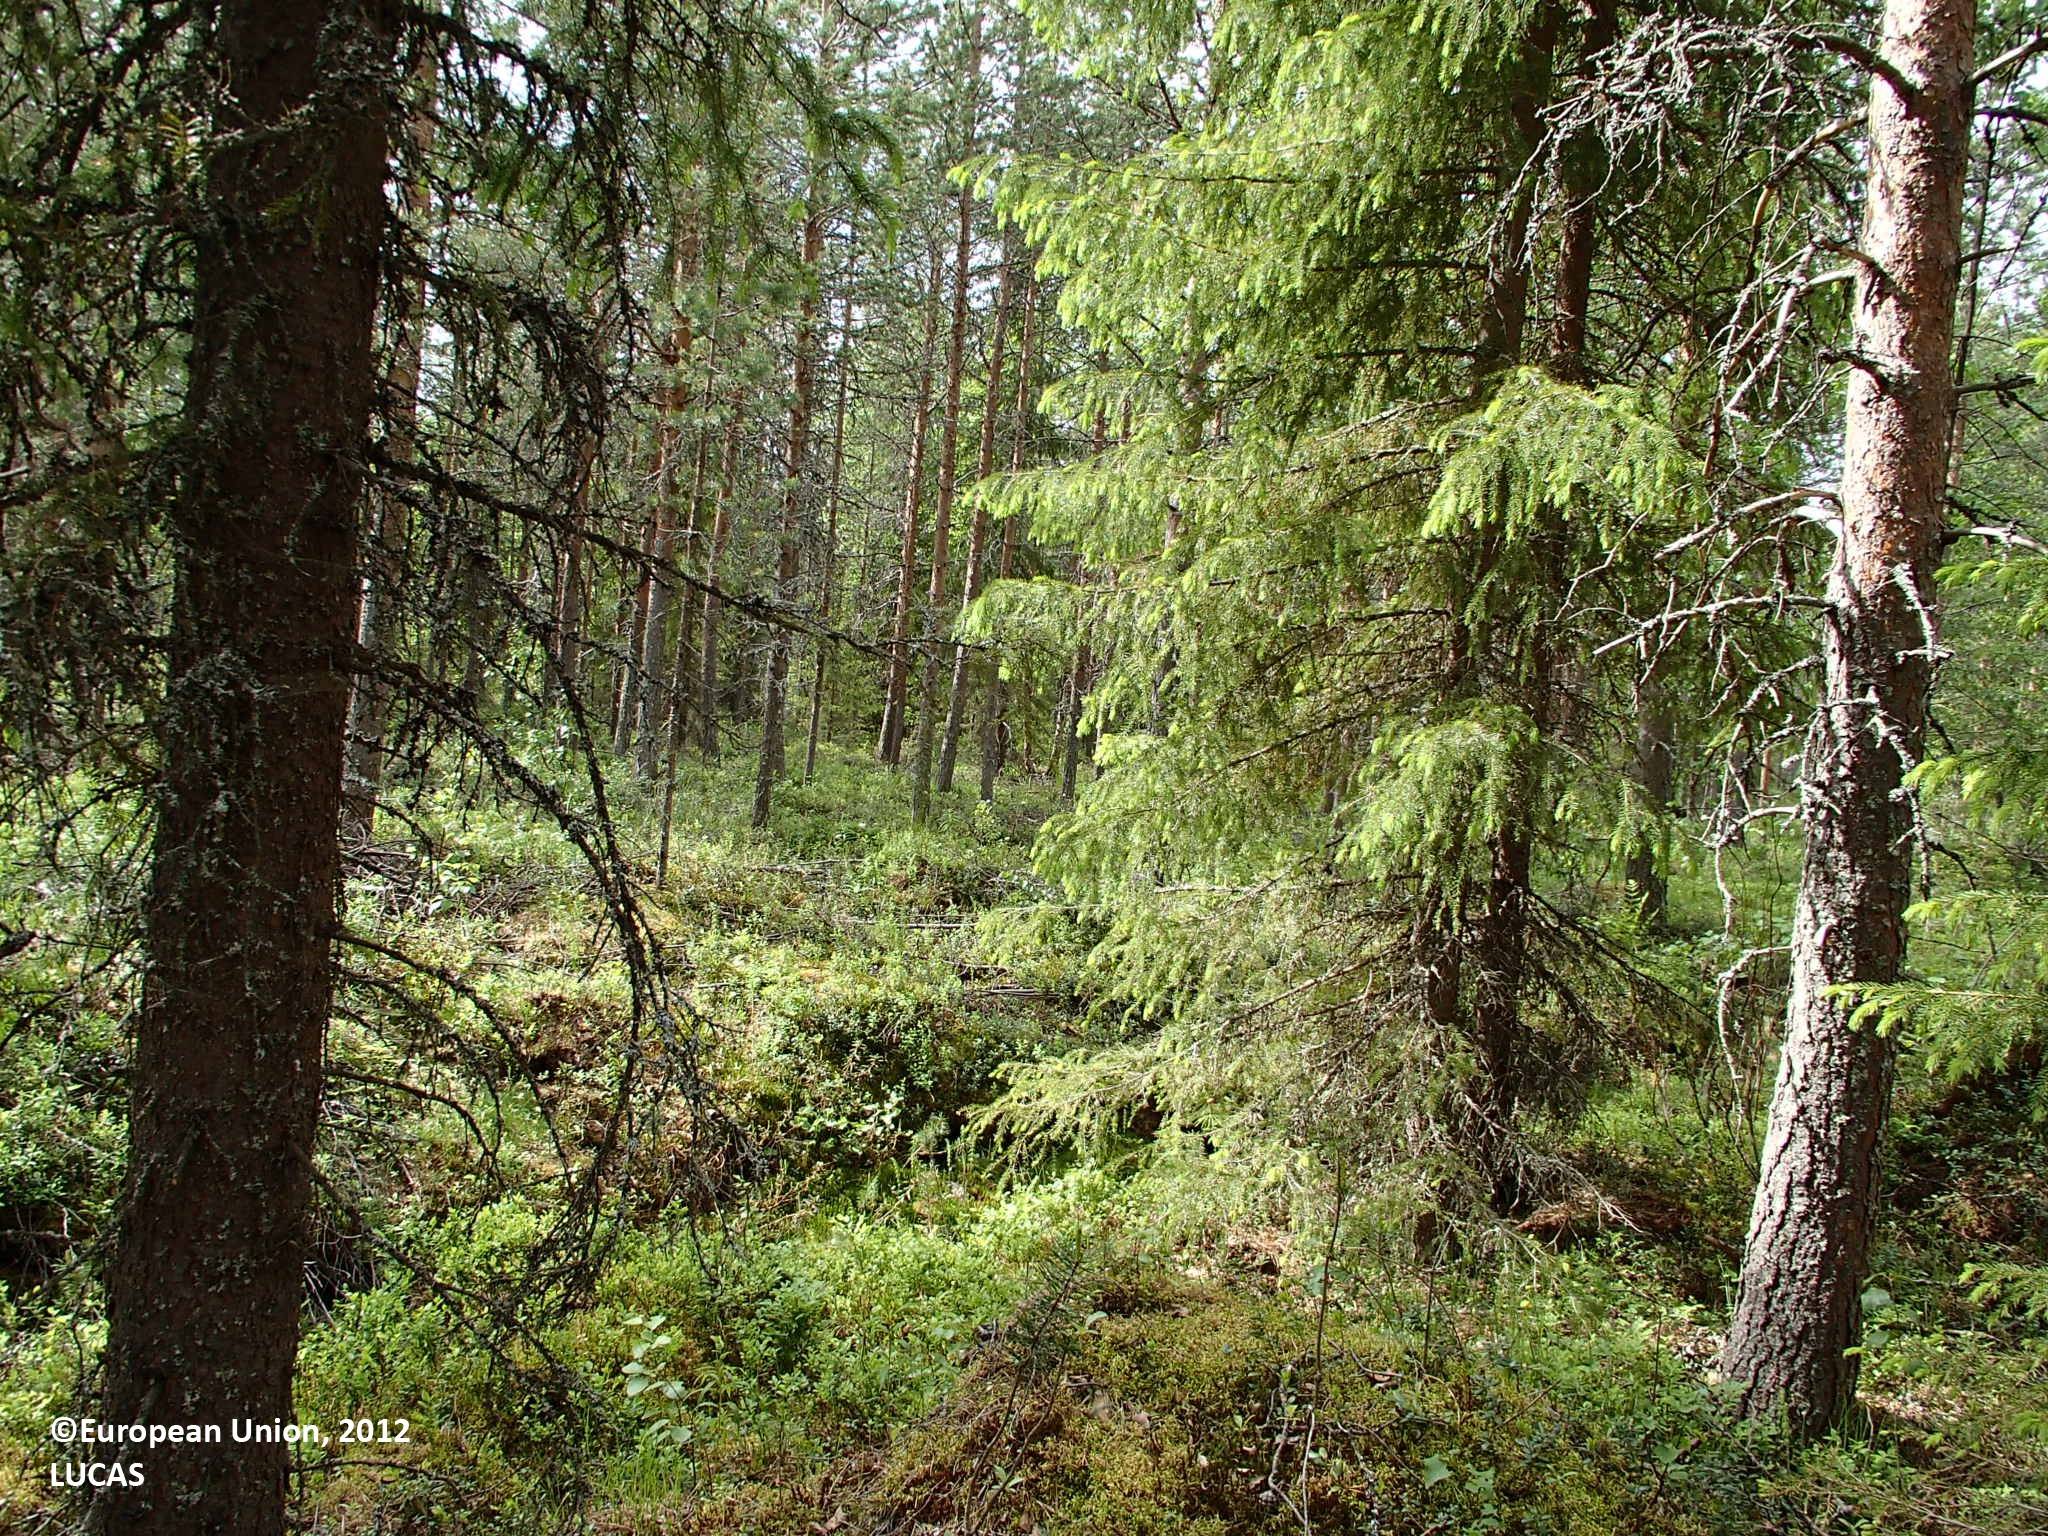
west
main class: Woodland
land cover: Pine dominated coniferous woodland
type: boreal forest
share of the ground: > 75 %
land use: Forestry
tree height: > 5 m
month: June
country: FI
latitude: 66.6041
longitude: 26.3535
